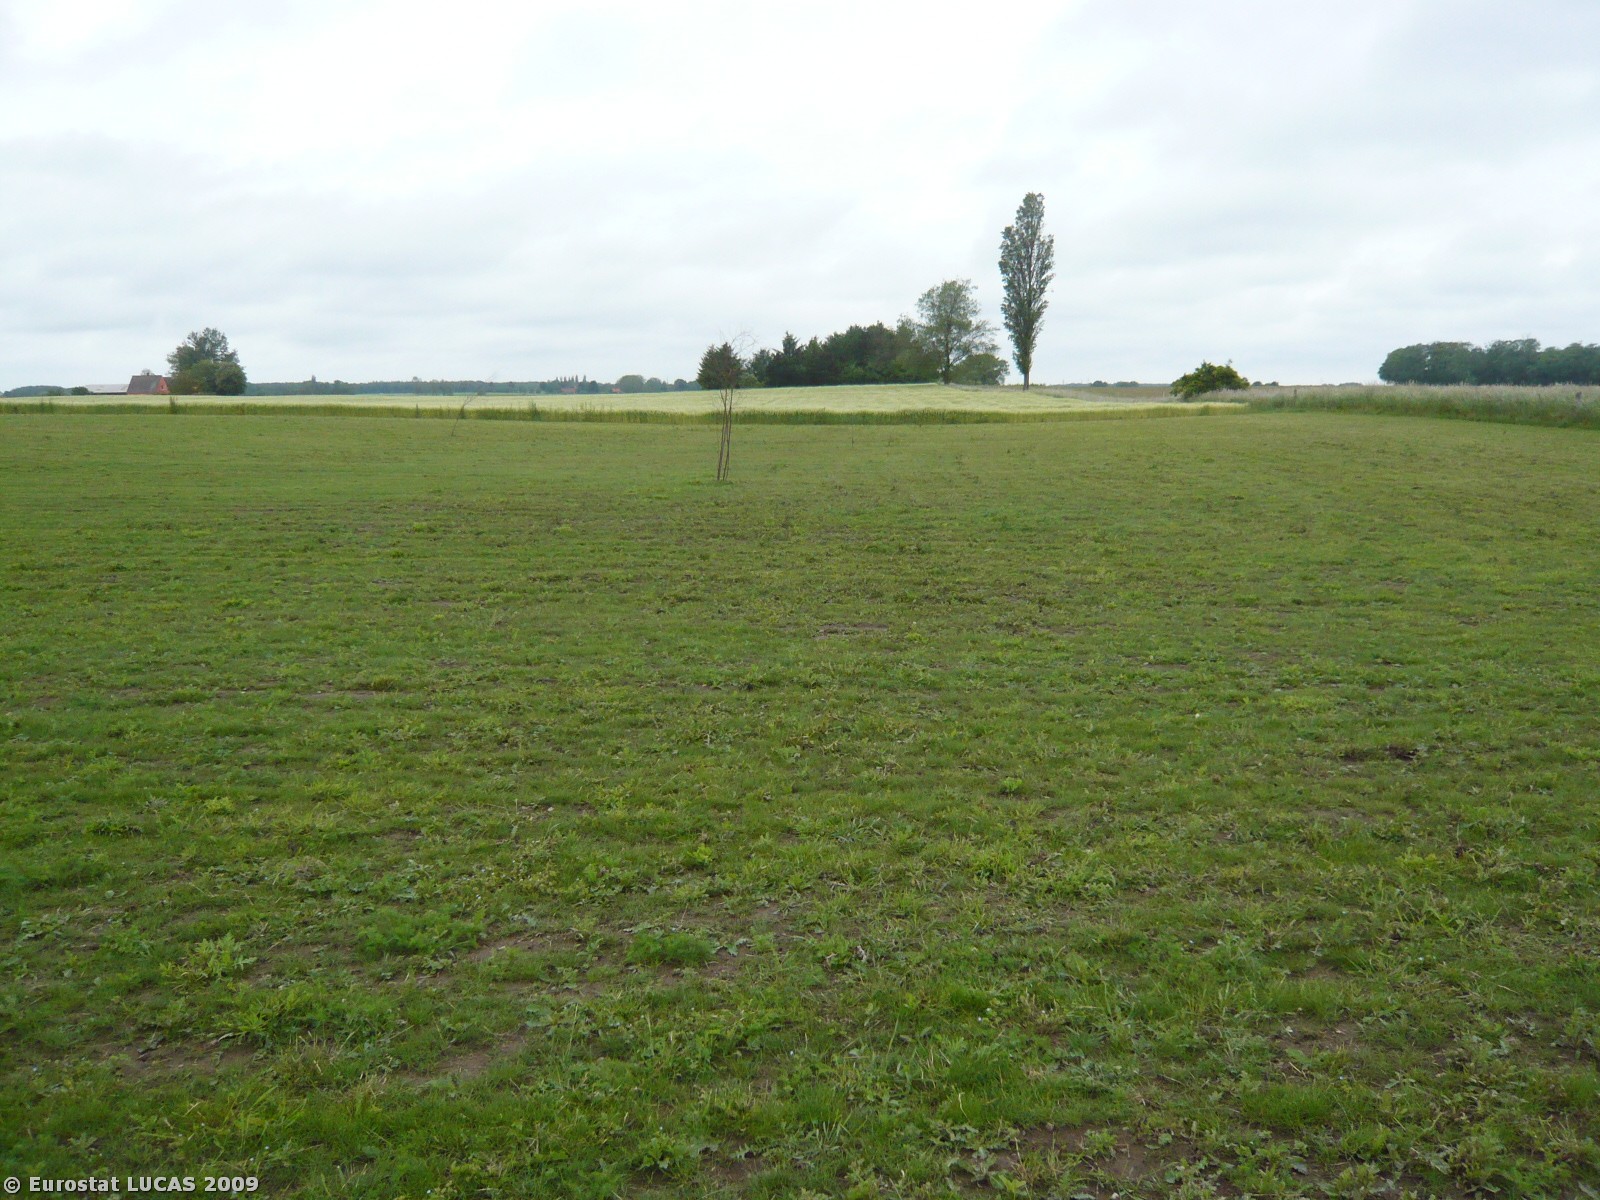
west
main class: Grassland
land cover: Grassland with sparse tree/shrub cover
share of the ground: > 75 %
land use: Residential
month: June
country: DK
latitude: 54.7522
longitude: 11.9720
